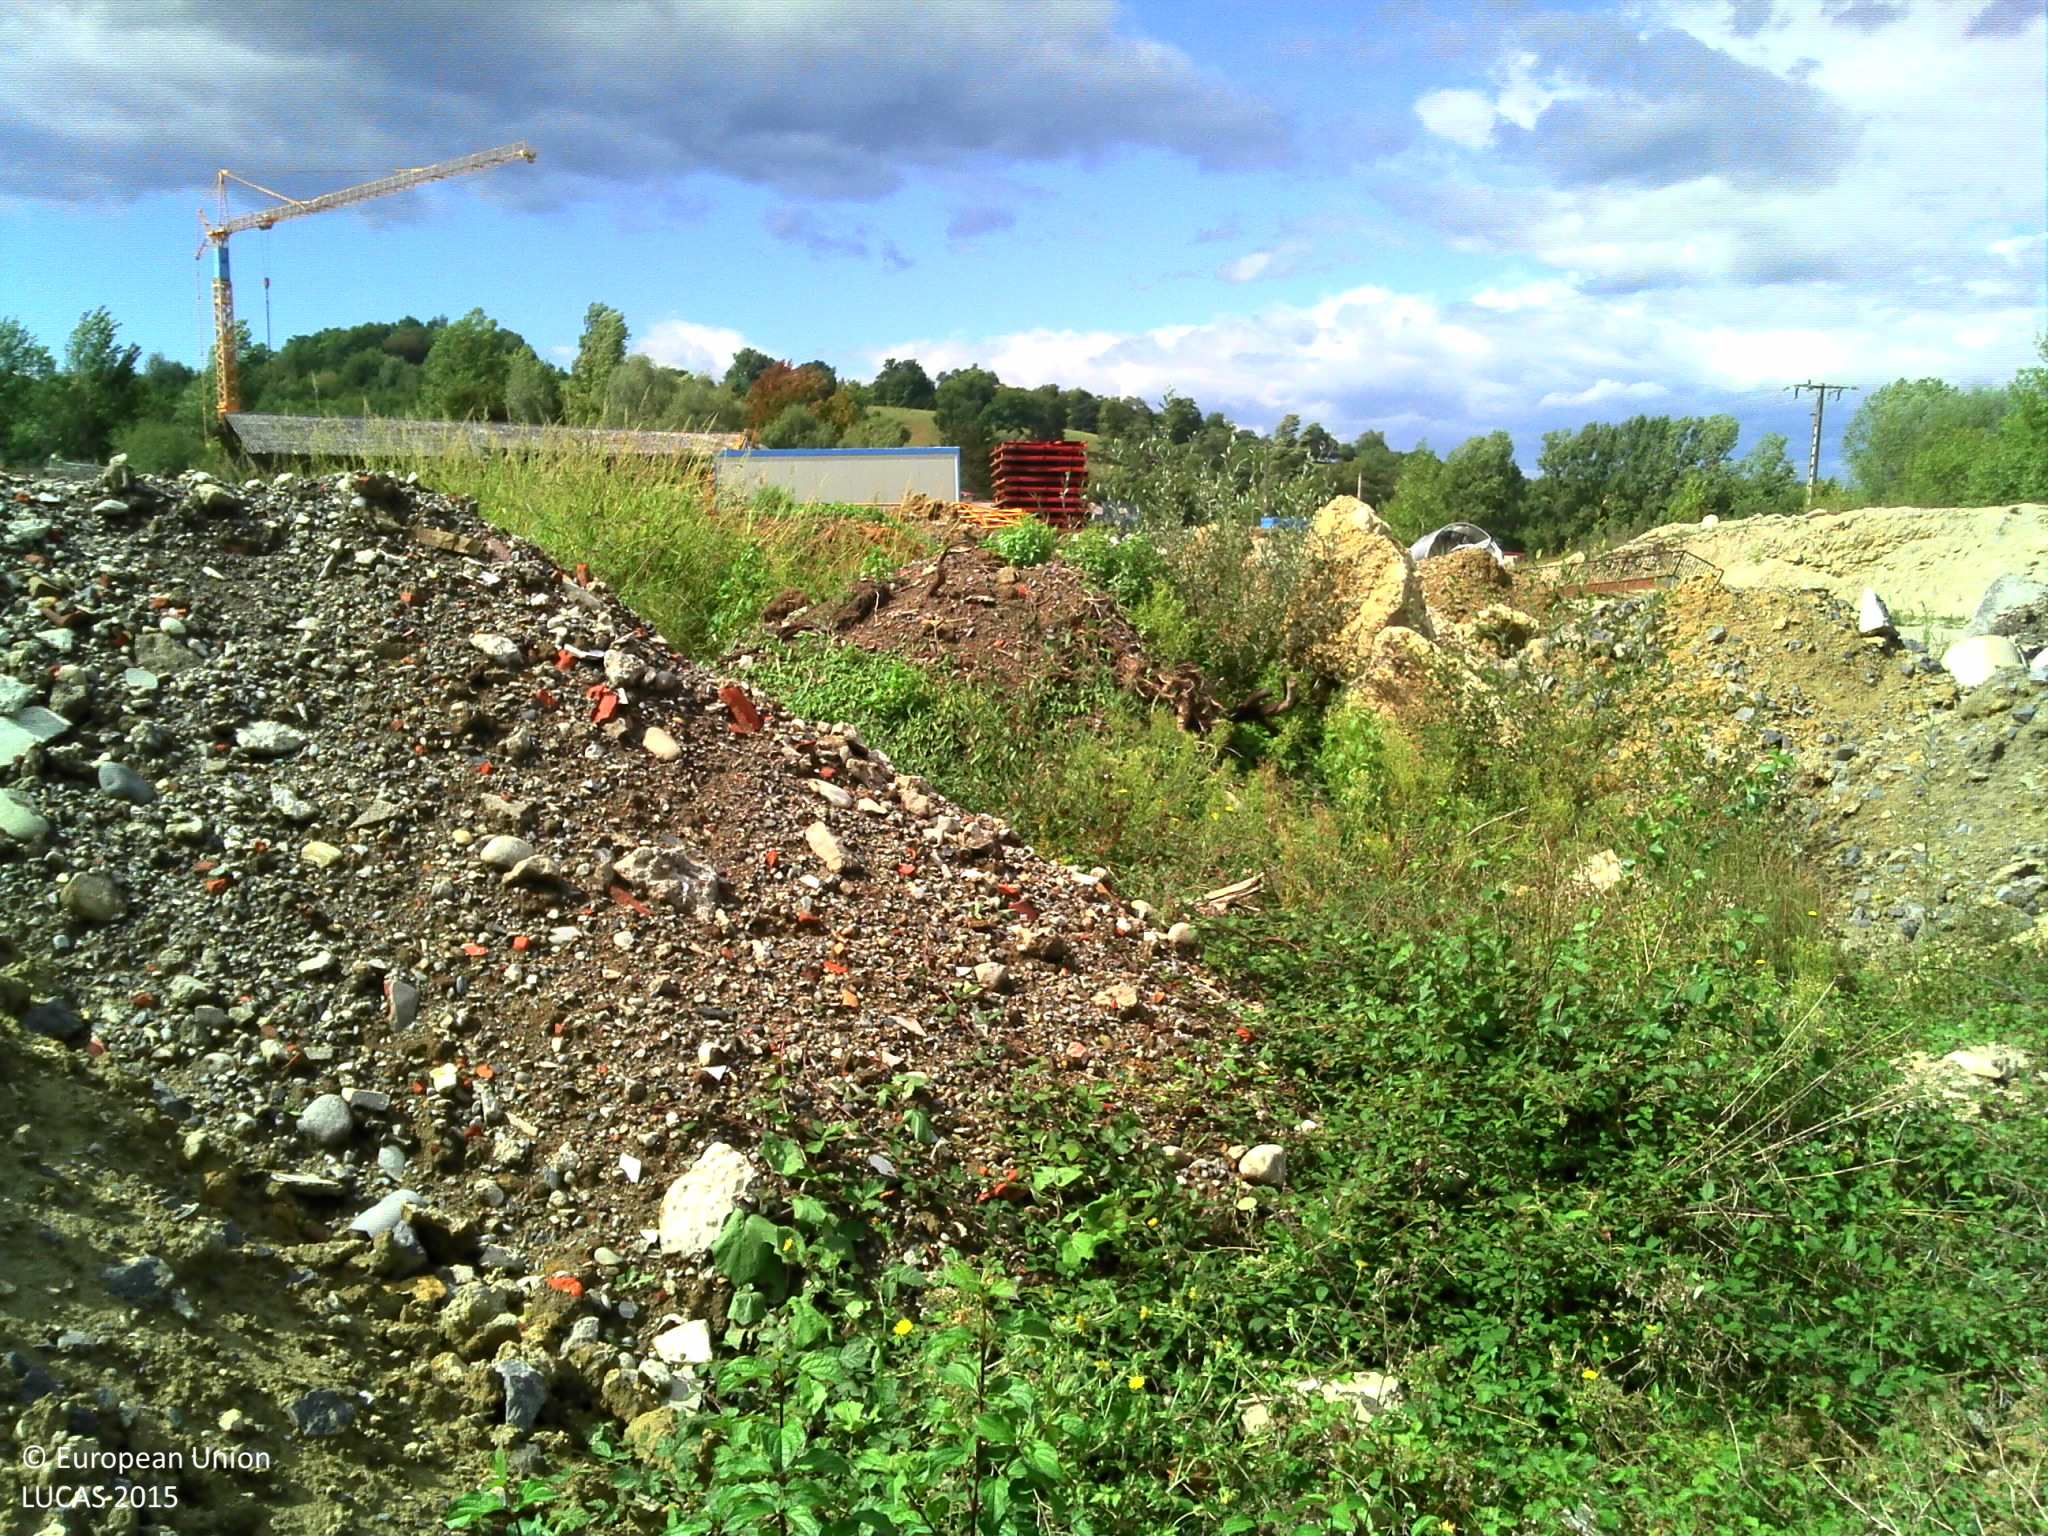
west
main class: Shrubland
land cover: Shrubland with sparse tree cover
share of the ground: > 75 %
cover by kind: shrubs 40 %, unconsolidated bare surface 30 %, herbaceous plants 20 %, broadleaved forest trees 5 %, consolidated bare surface 5 %
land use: Abandoned areas
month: September
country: FR
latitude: 43.4273
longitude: -0.7453
